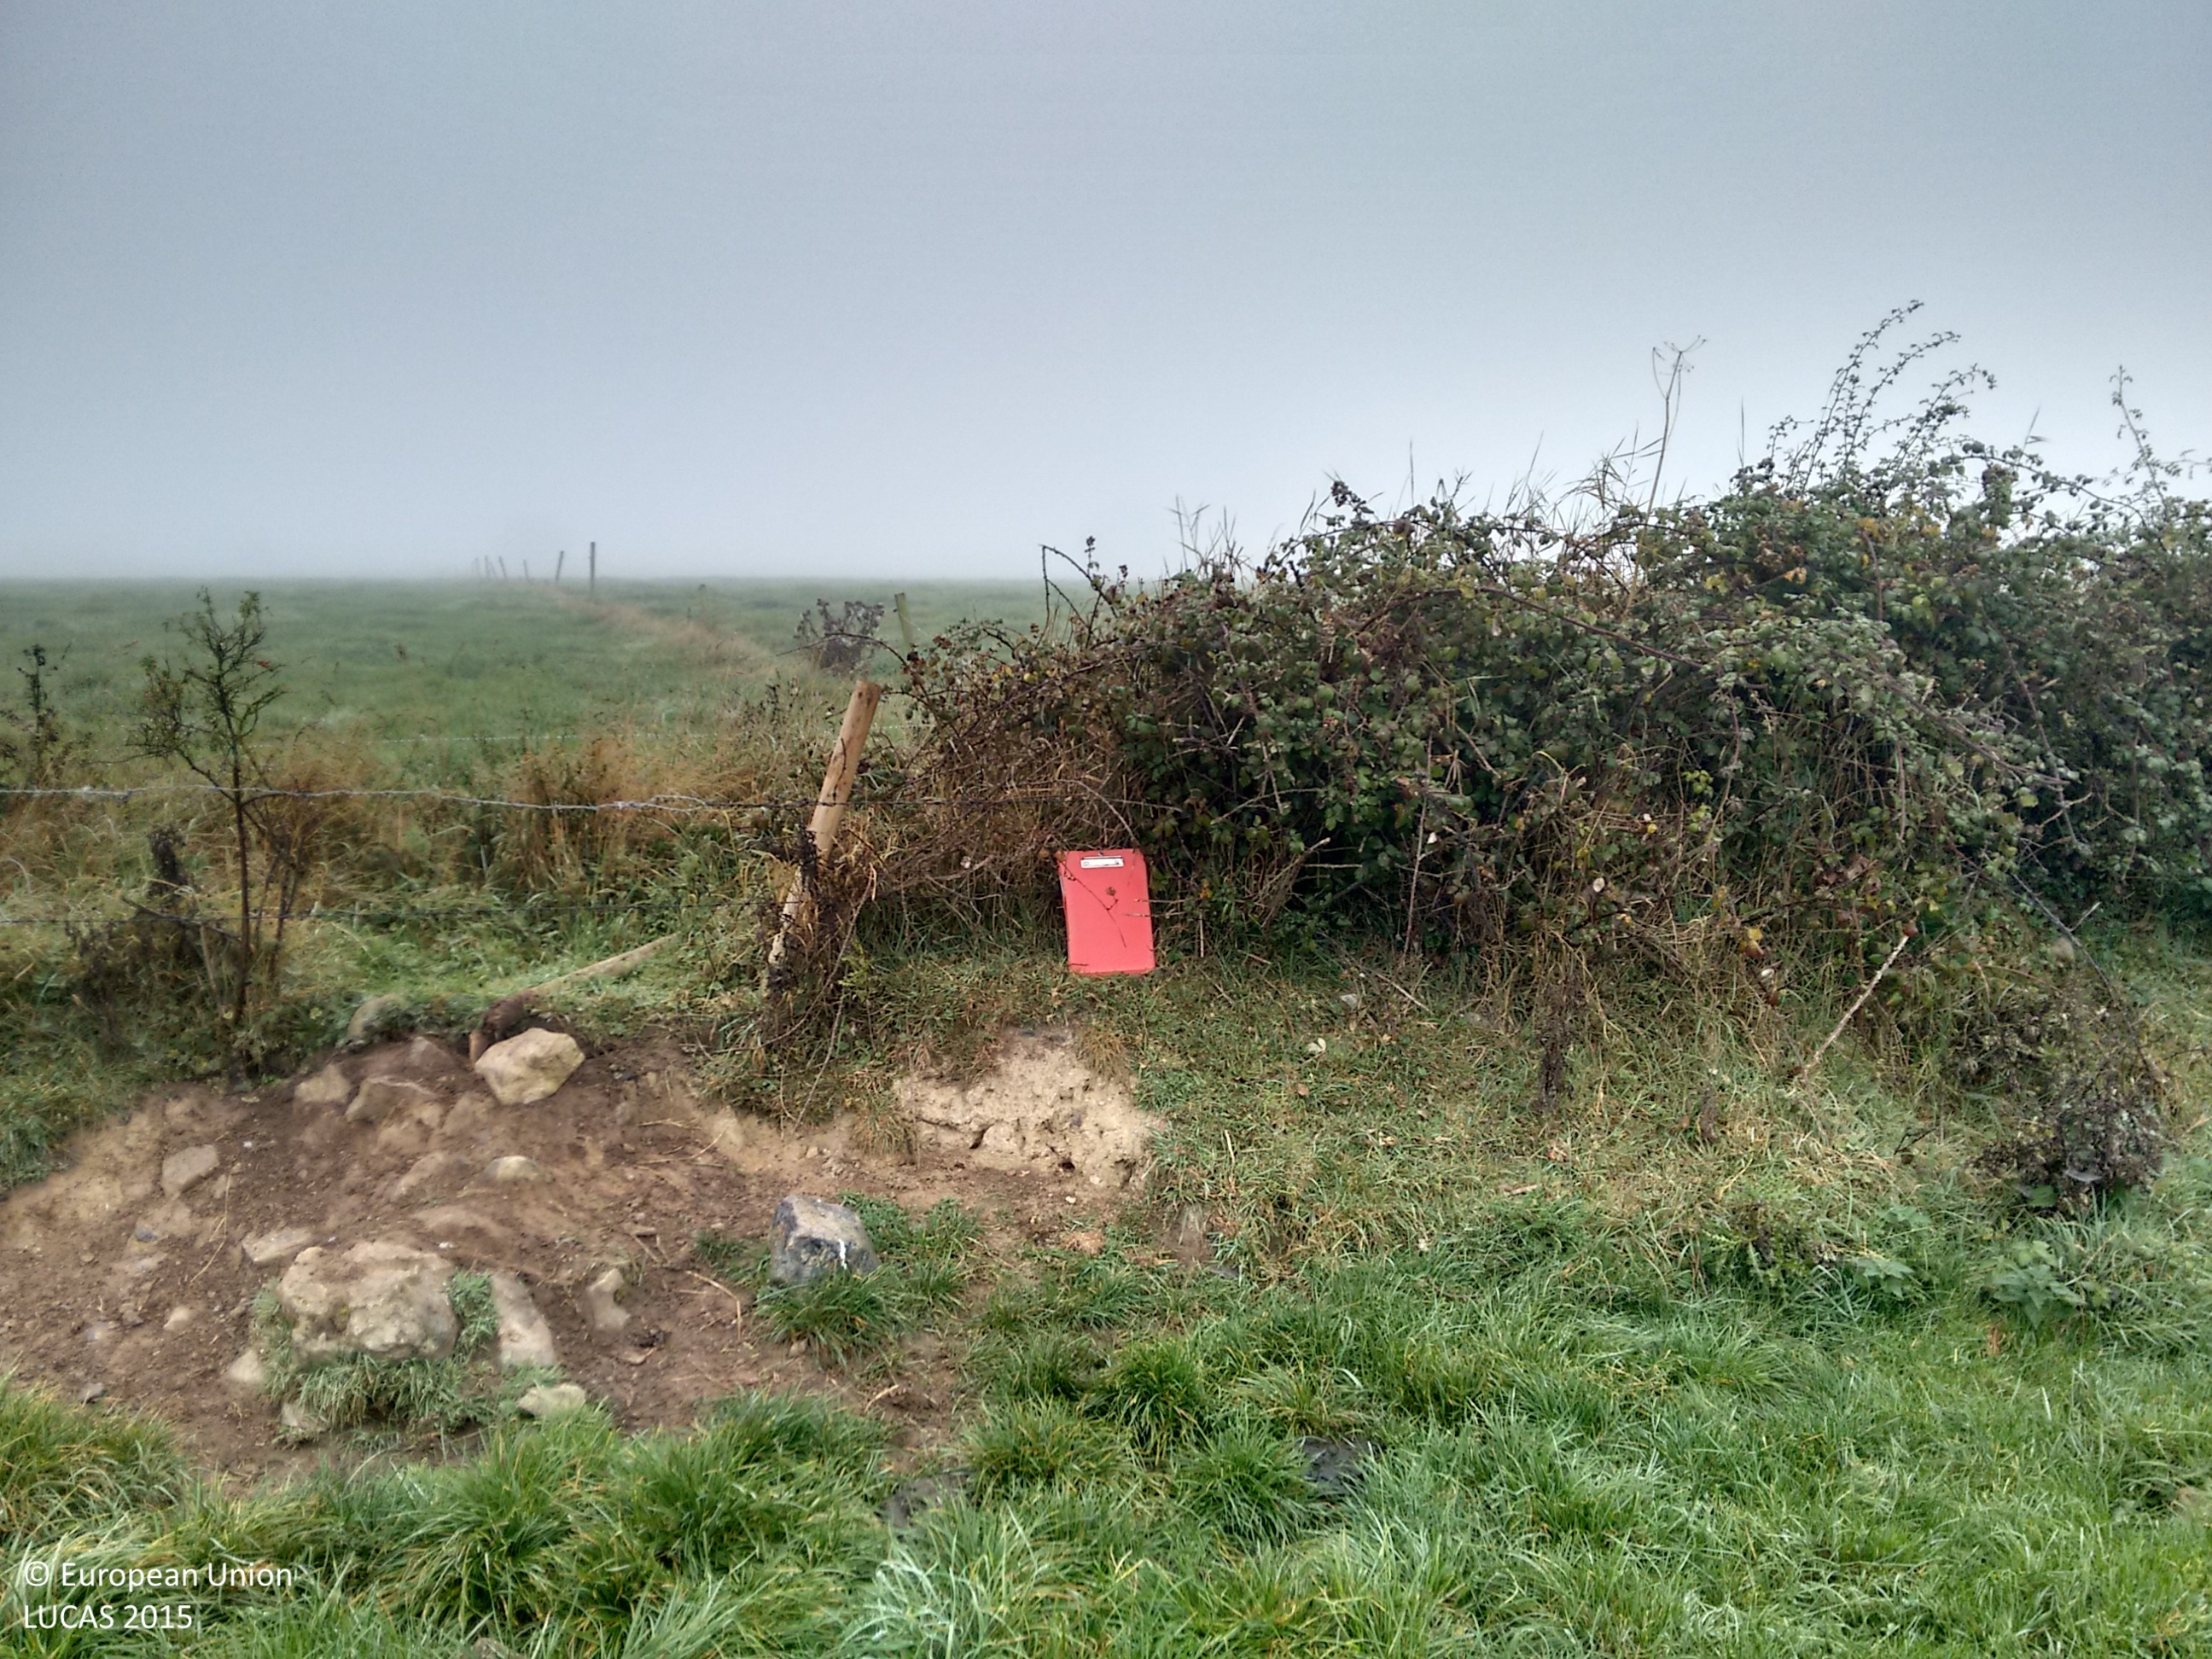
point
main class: Grassland
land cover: Grassland without tree/shrub cover
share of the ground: > 75 %
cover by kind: herbaceous plants 100 %
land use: Agriculture (excluding fallow land and kitchen gardens)
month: October
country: IE
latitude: 52.6390
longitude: -7.7985
